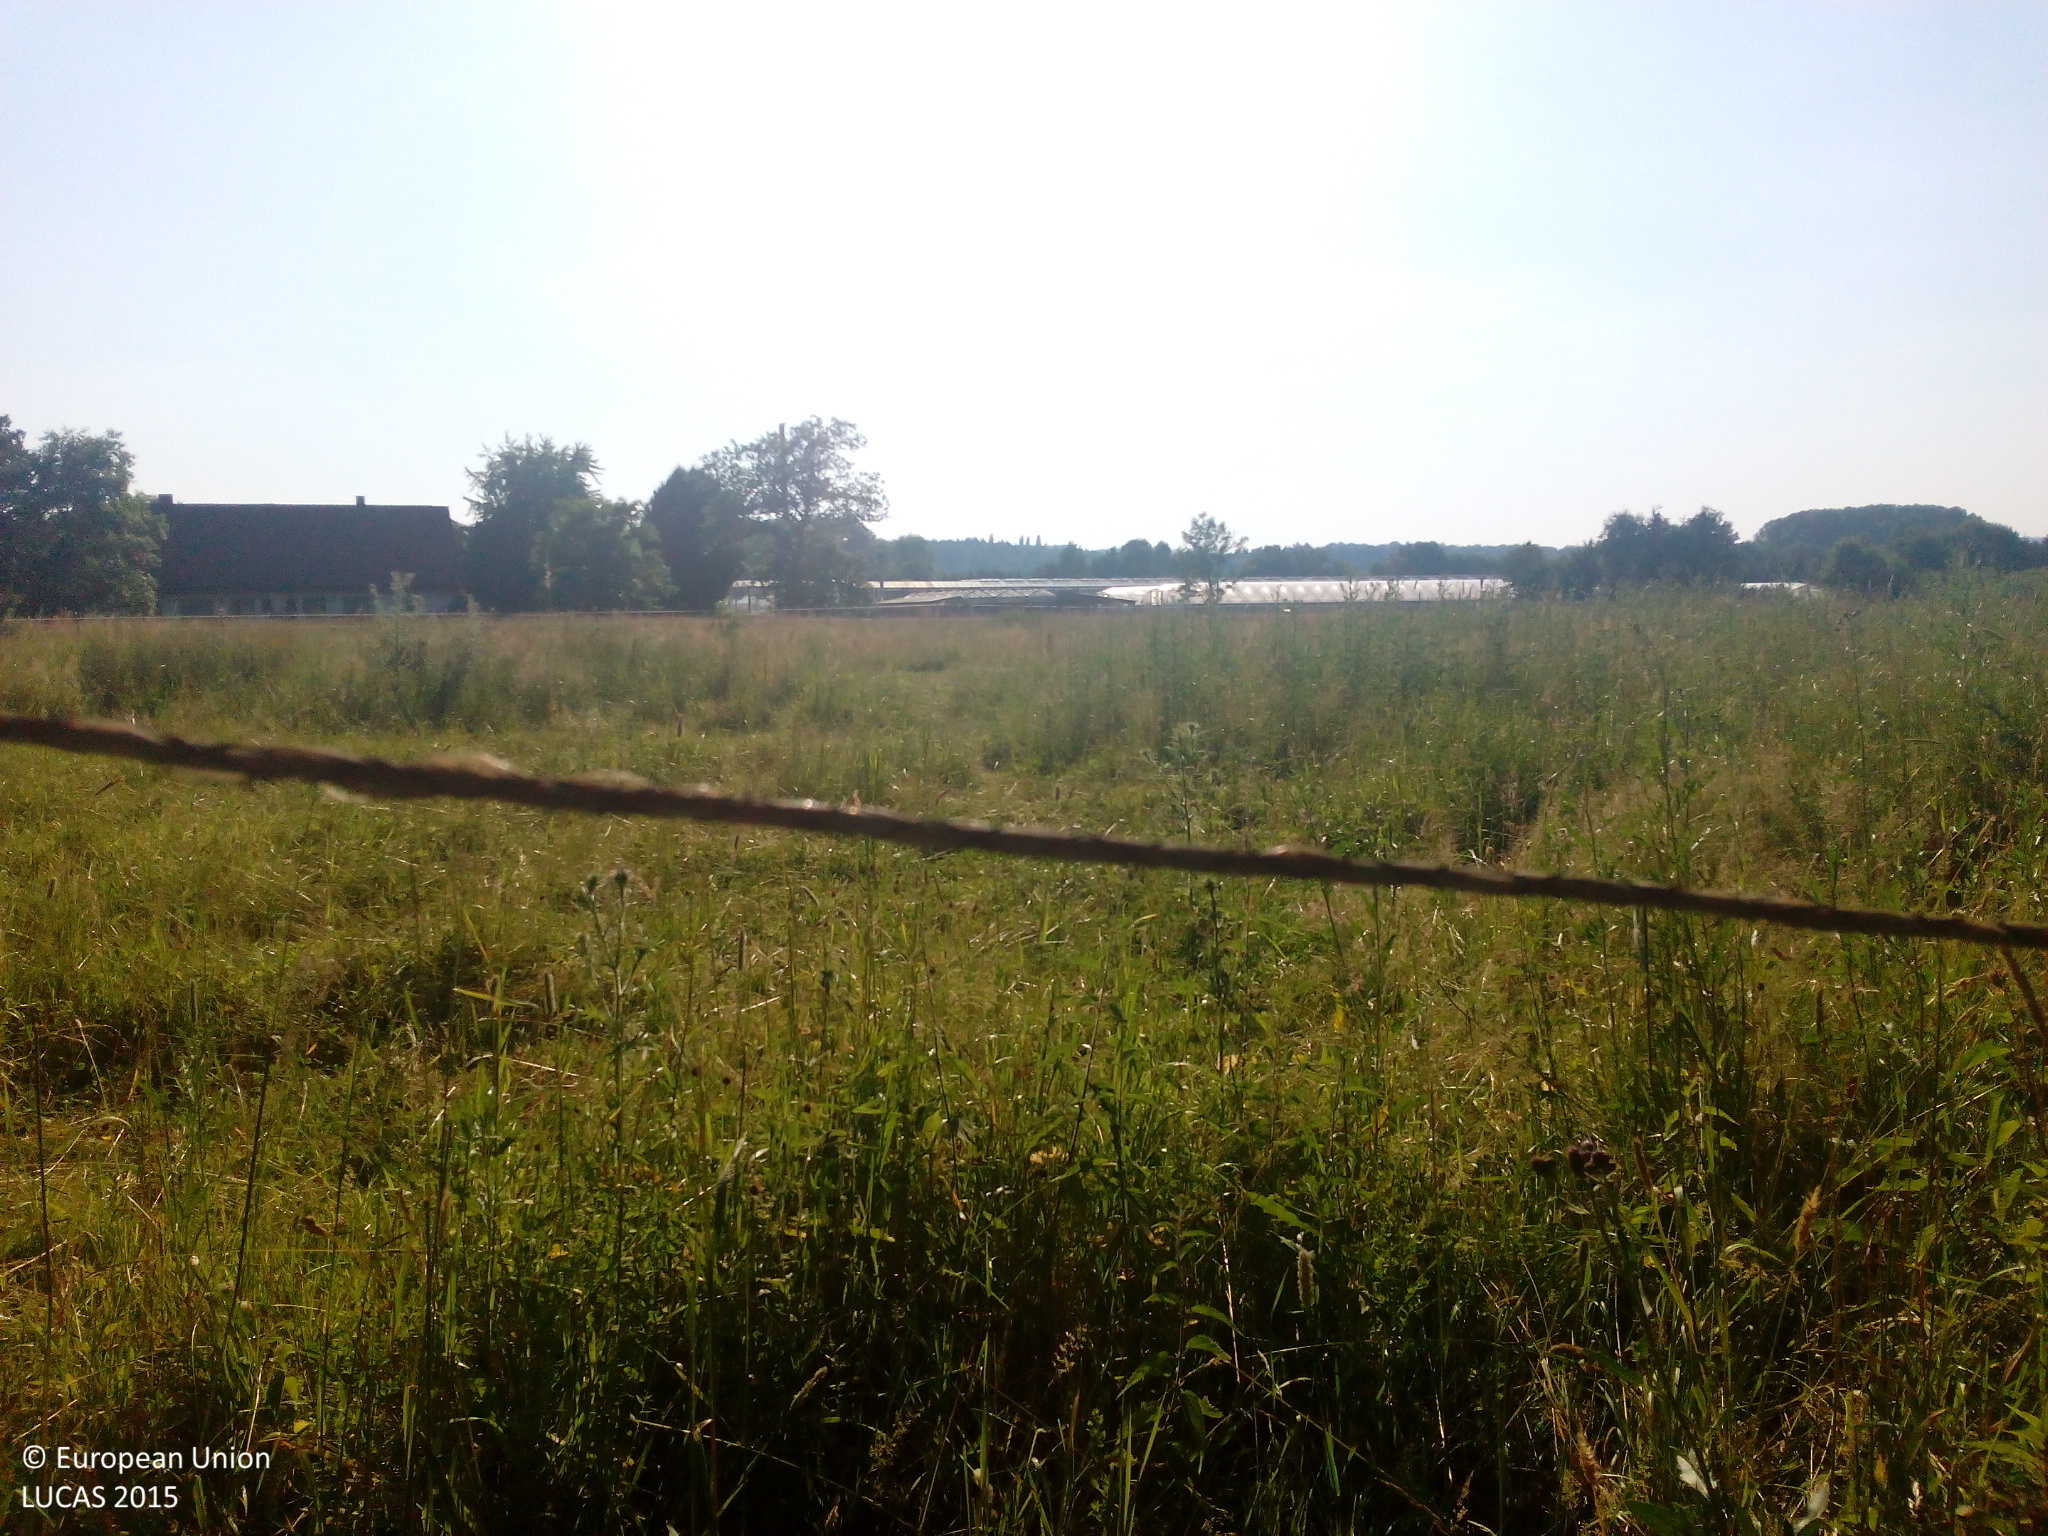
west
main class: Grassland
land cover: Grassland without tree/shrub cover
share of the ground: > 75 %
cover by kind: herbaceous plants 100 %
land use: Agriculture (excluding fallow land and kitchen gardens)
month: July
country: DE
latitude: 50.1014
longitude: 11.5794
